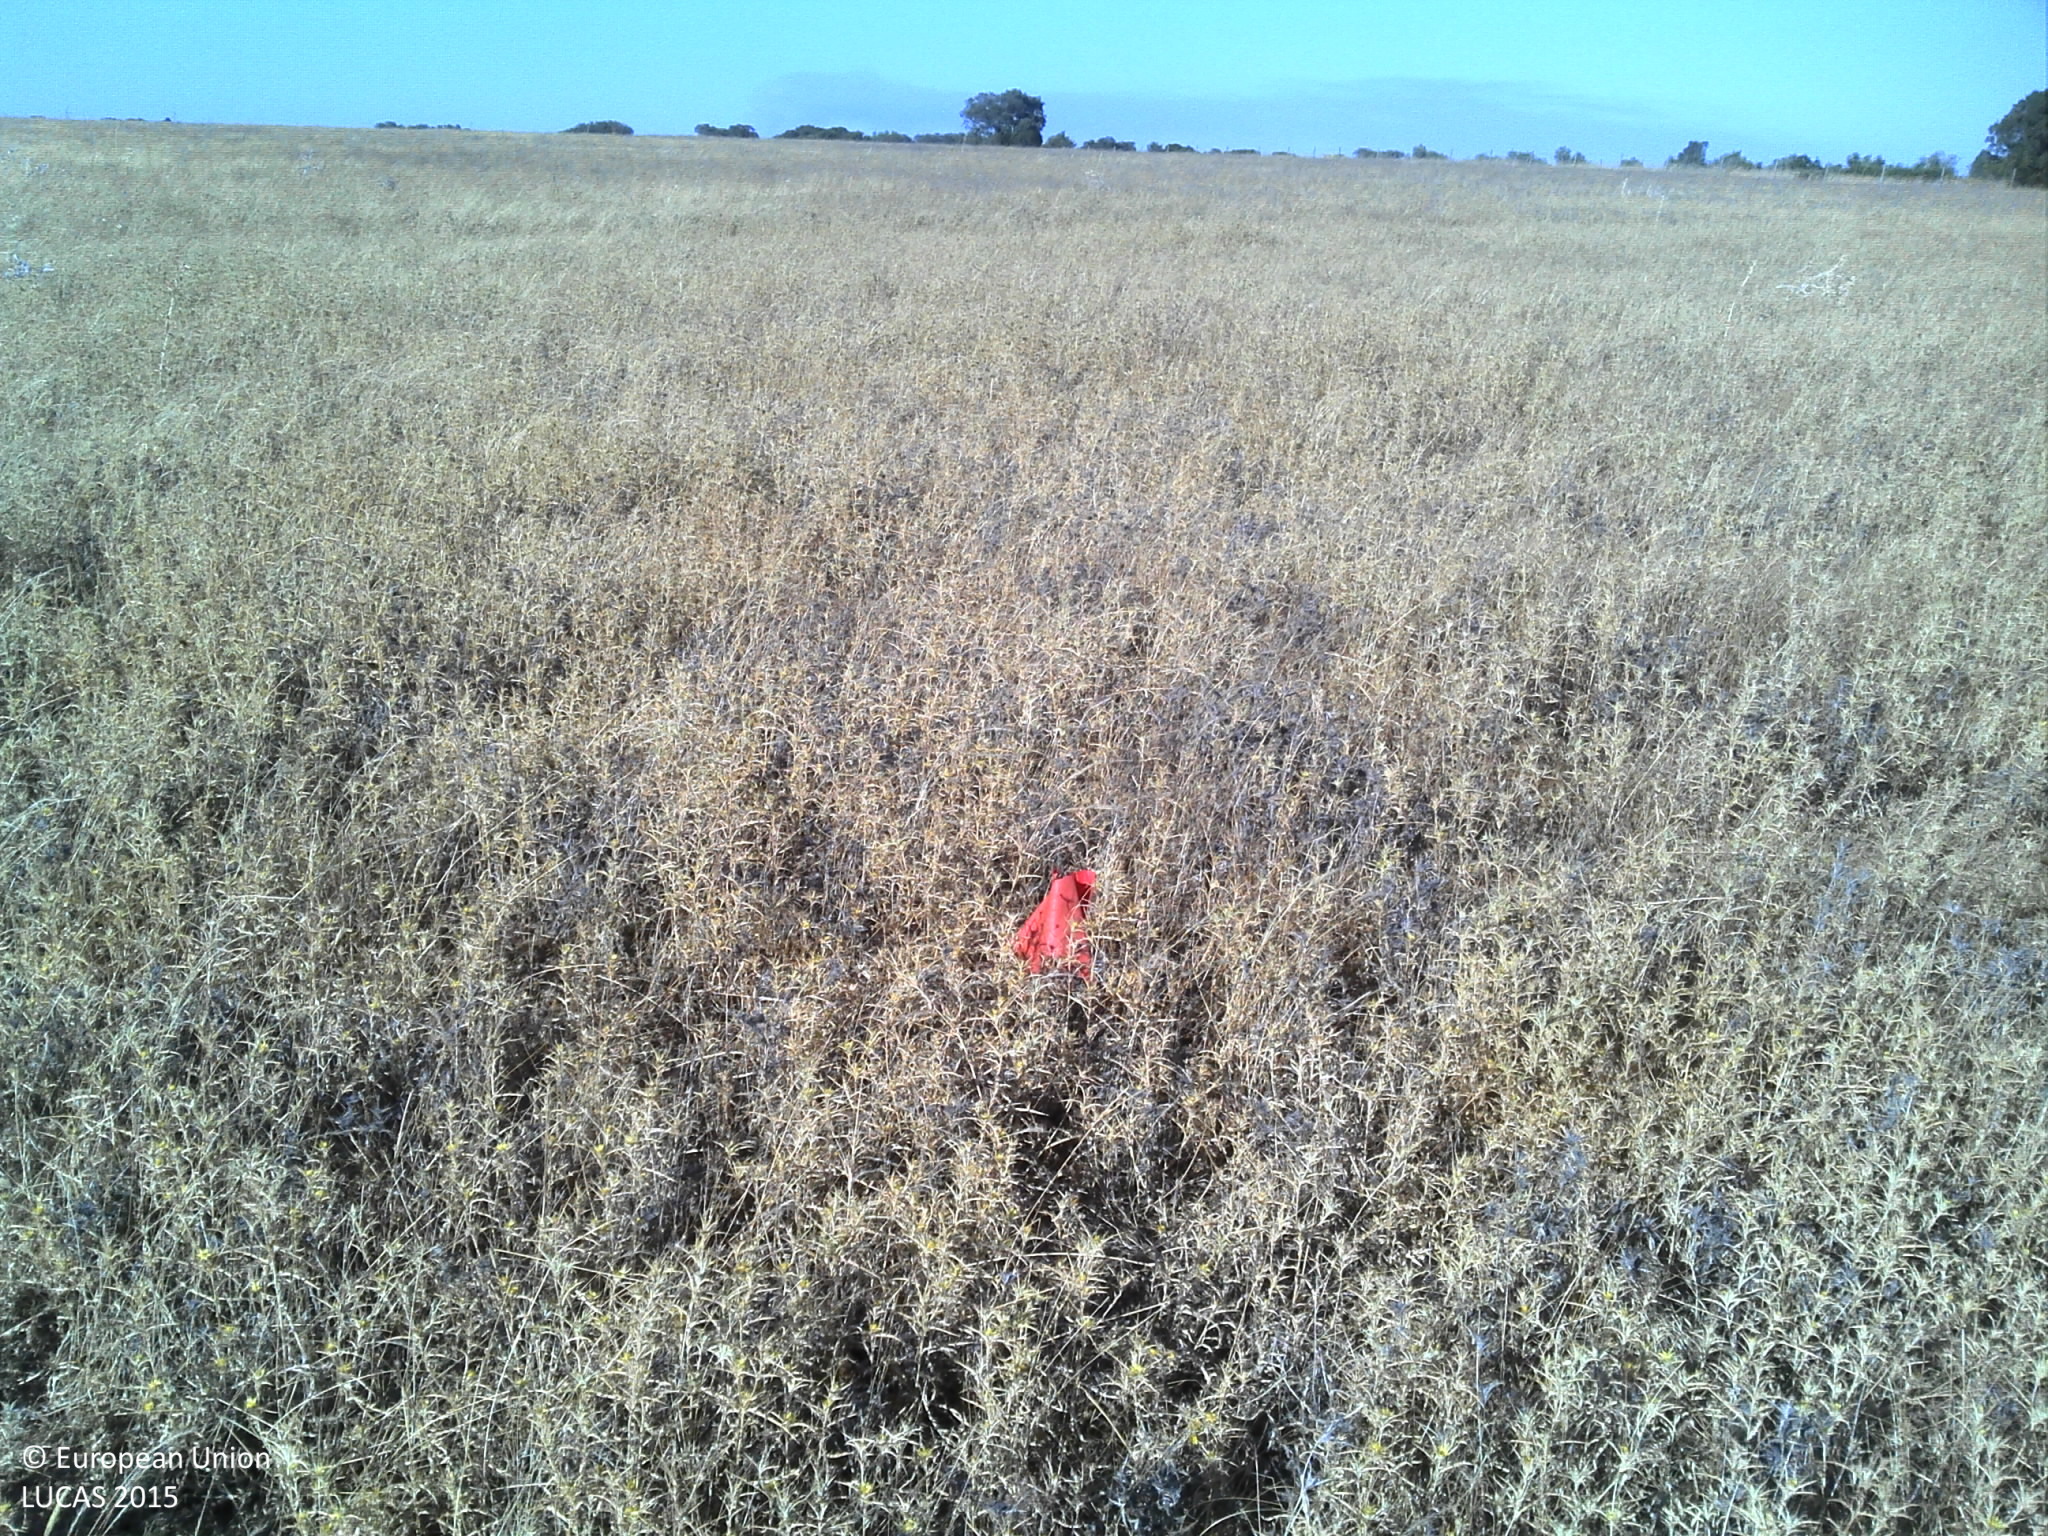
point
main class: Grassland
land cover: Grassland without tree/shrub cover
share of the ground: 50 - 75 %
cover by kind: herbaceous plants 70 %, unconsolidated bare surface 25 %
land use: Agriculture (excluding fallow land and kitchen gardens)
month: July
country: PT
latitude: 37.9010
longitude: -8.0090
